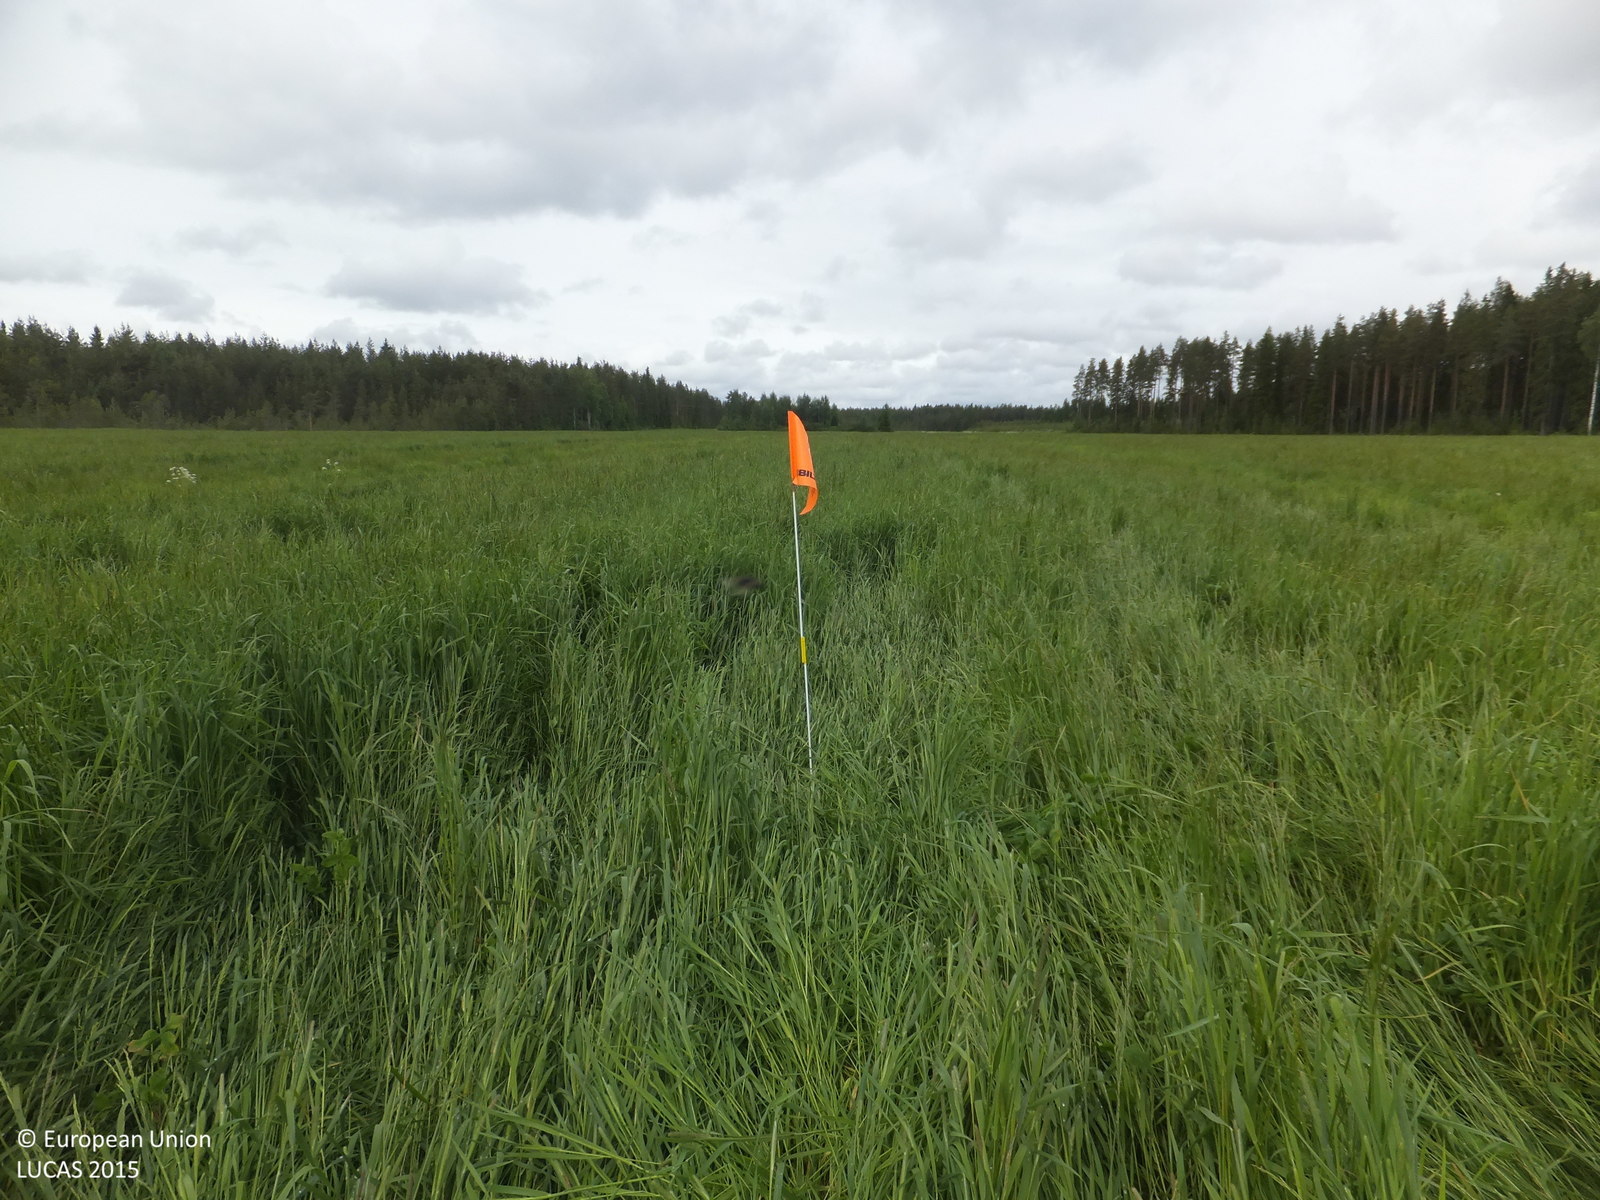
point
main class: Cropland
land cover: Temporary grasslands
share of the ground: > 75 %
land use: Agriculture (excluding fallow land and kitchen gardens)
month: June
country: FI
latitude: 63.3188
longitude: 23.9446
